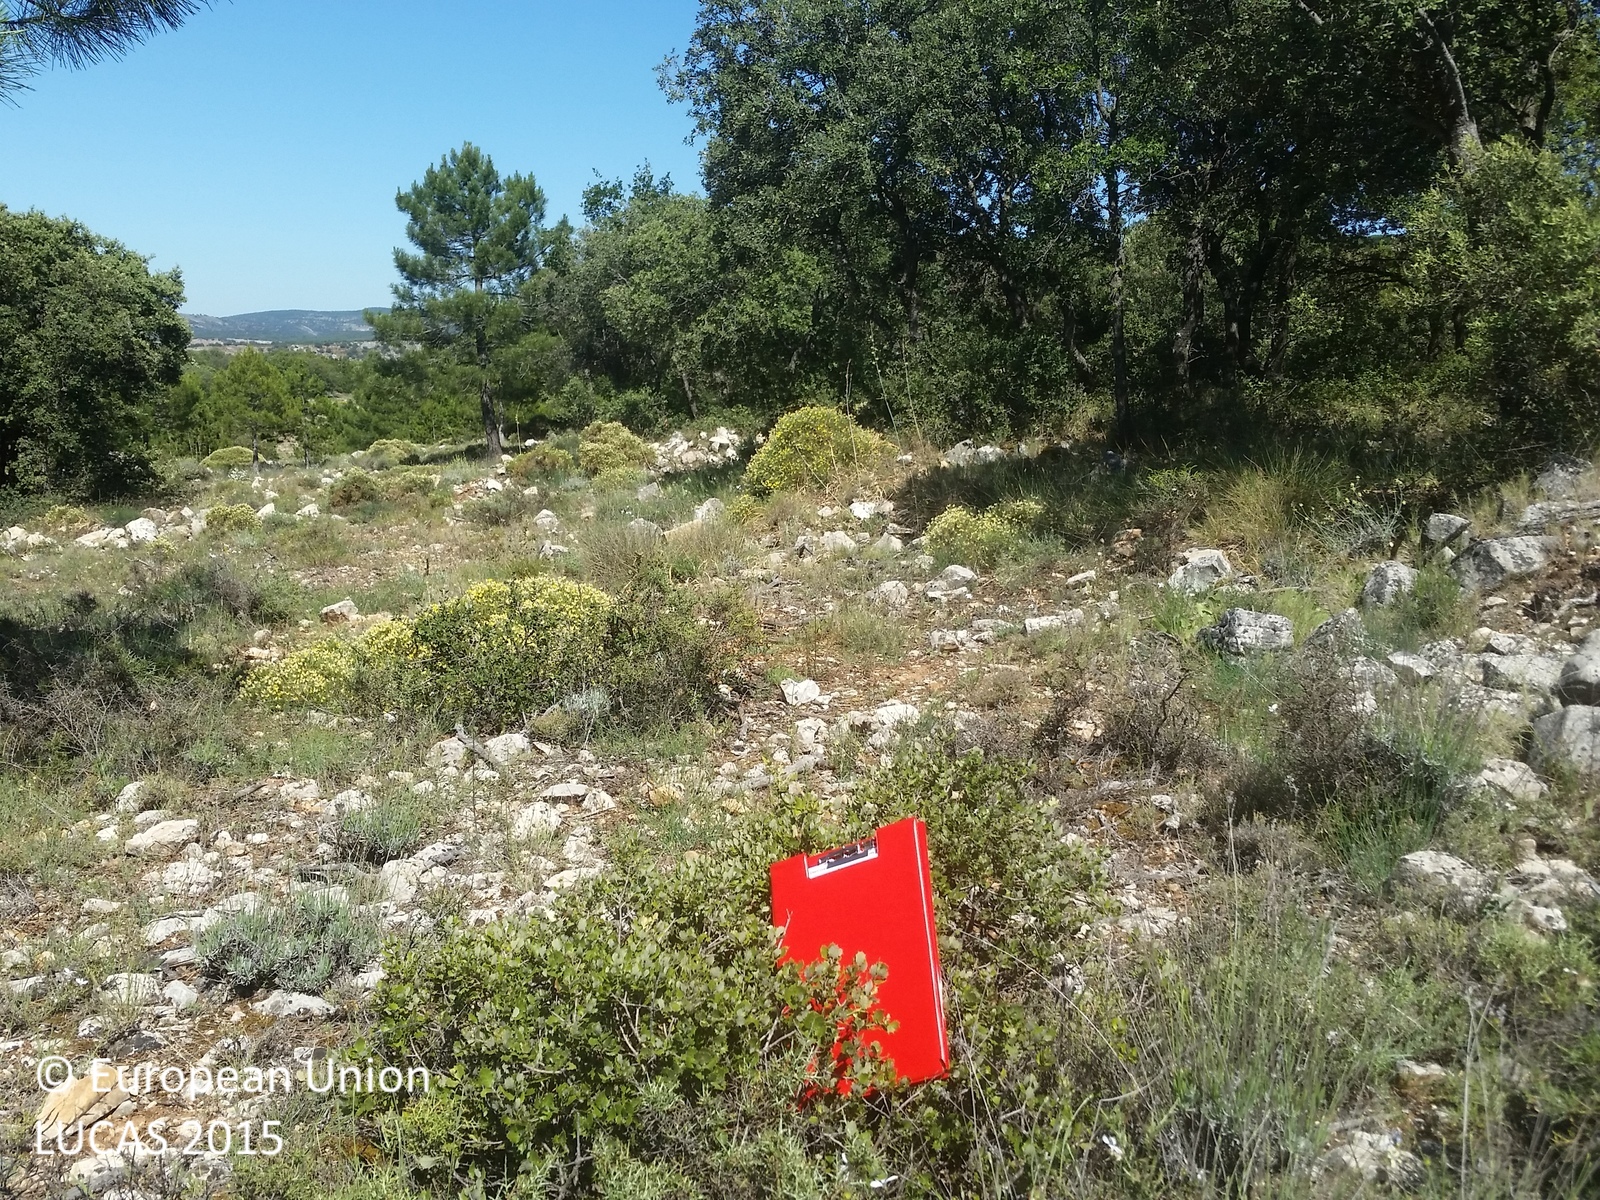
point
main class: Woodland
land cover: Pine dominated mixed woodland
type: coniferous forest of the mediterranean region
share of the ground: > 75 %
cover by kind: shrubs 30 %, coniferous forest trees 25 %, broadleaved forest trees 25 %, consolidated bare surface 15 %, herbaceous plants 5 %
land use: Forestry
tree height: > 5 m
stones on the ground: 10 - 25 %
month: June
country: ES
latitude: 38.5771
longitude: -2.5698
